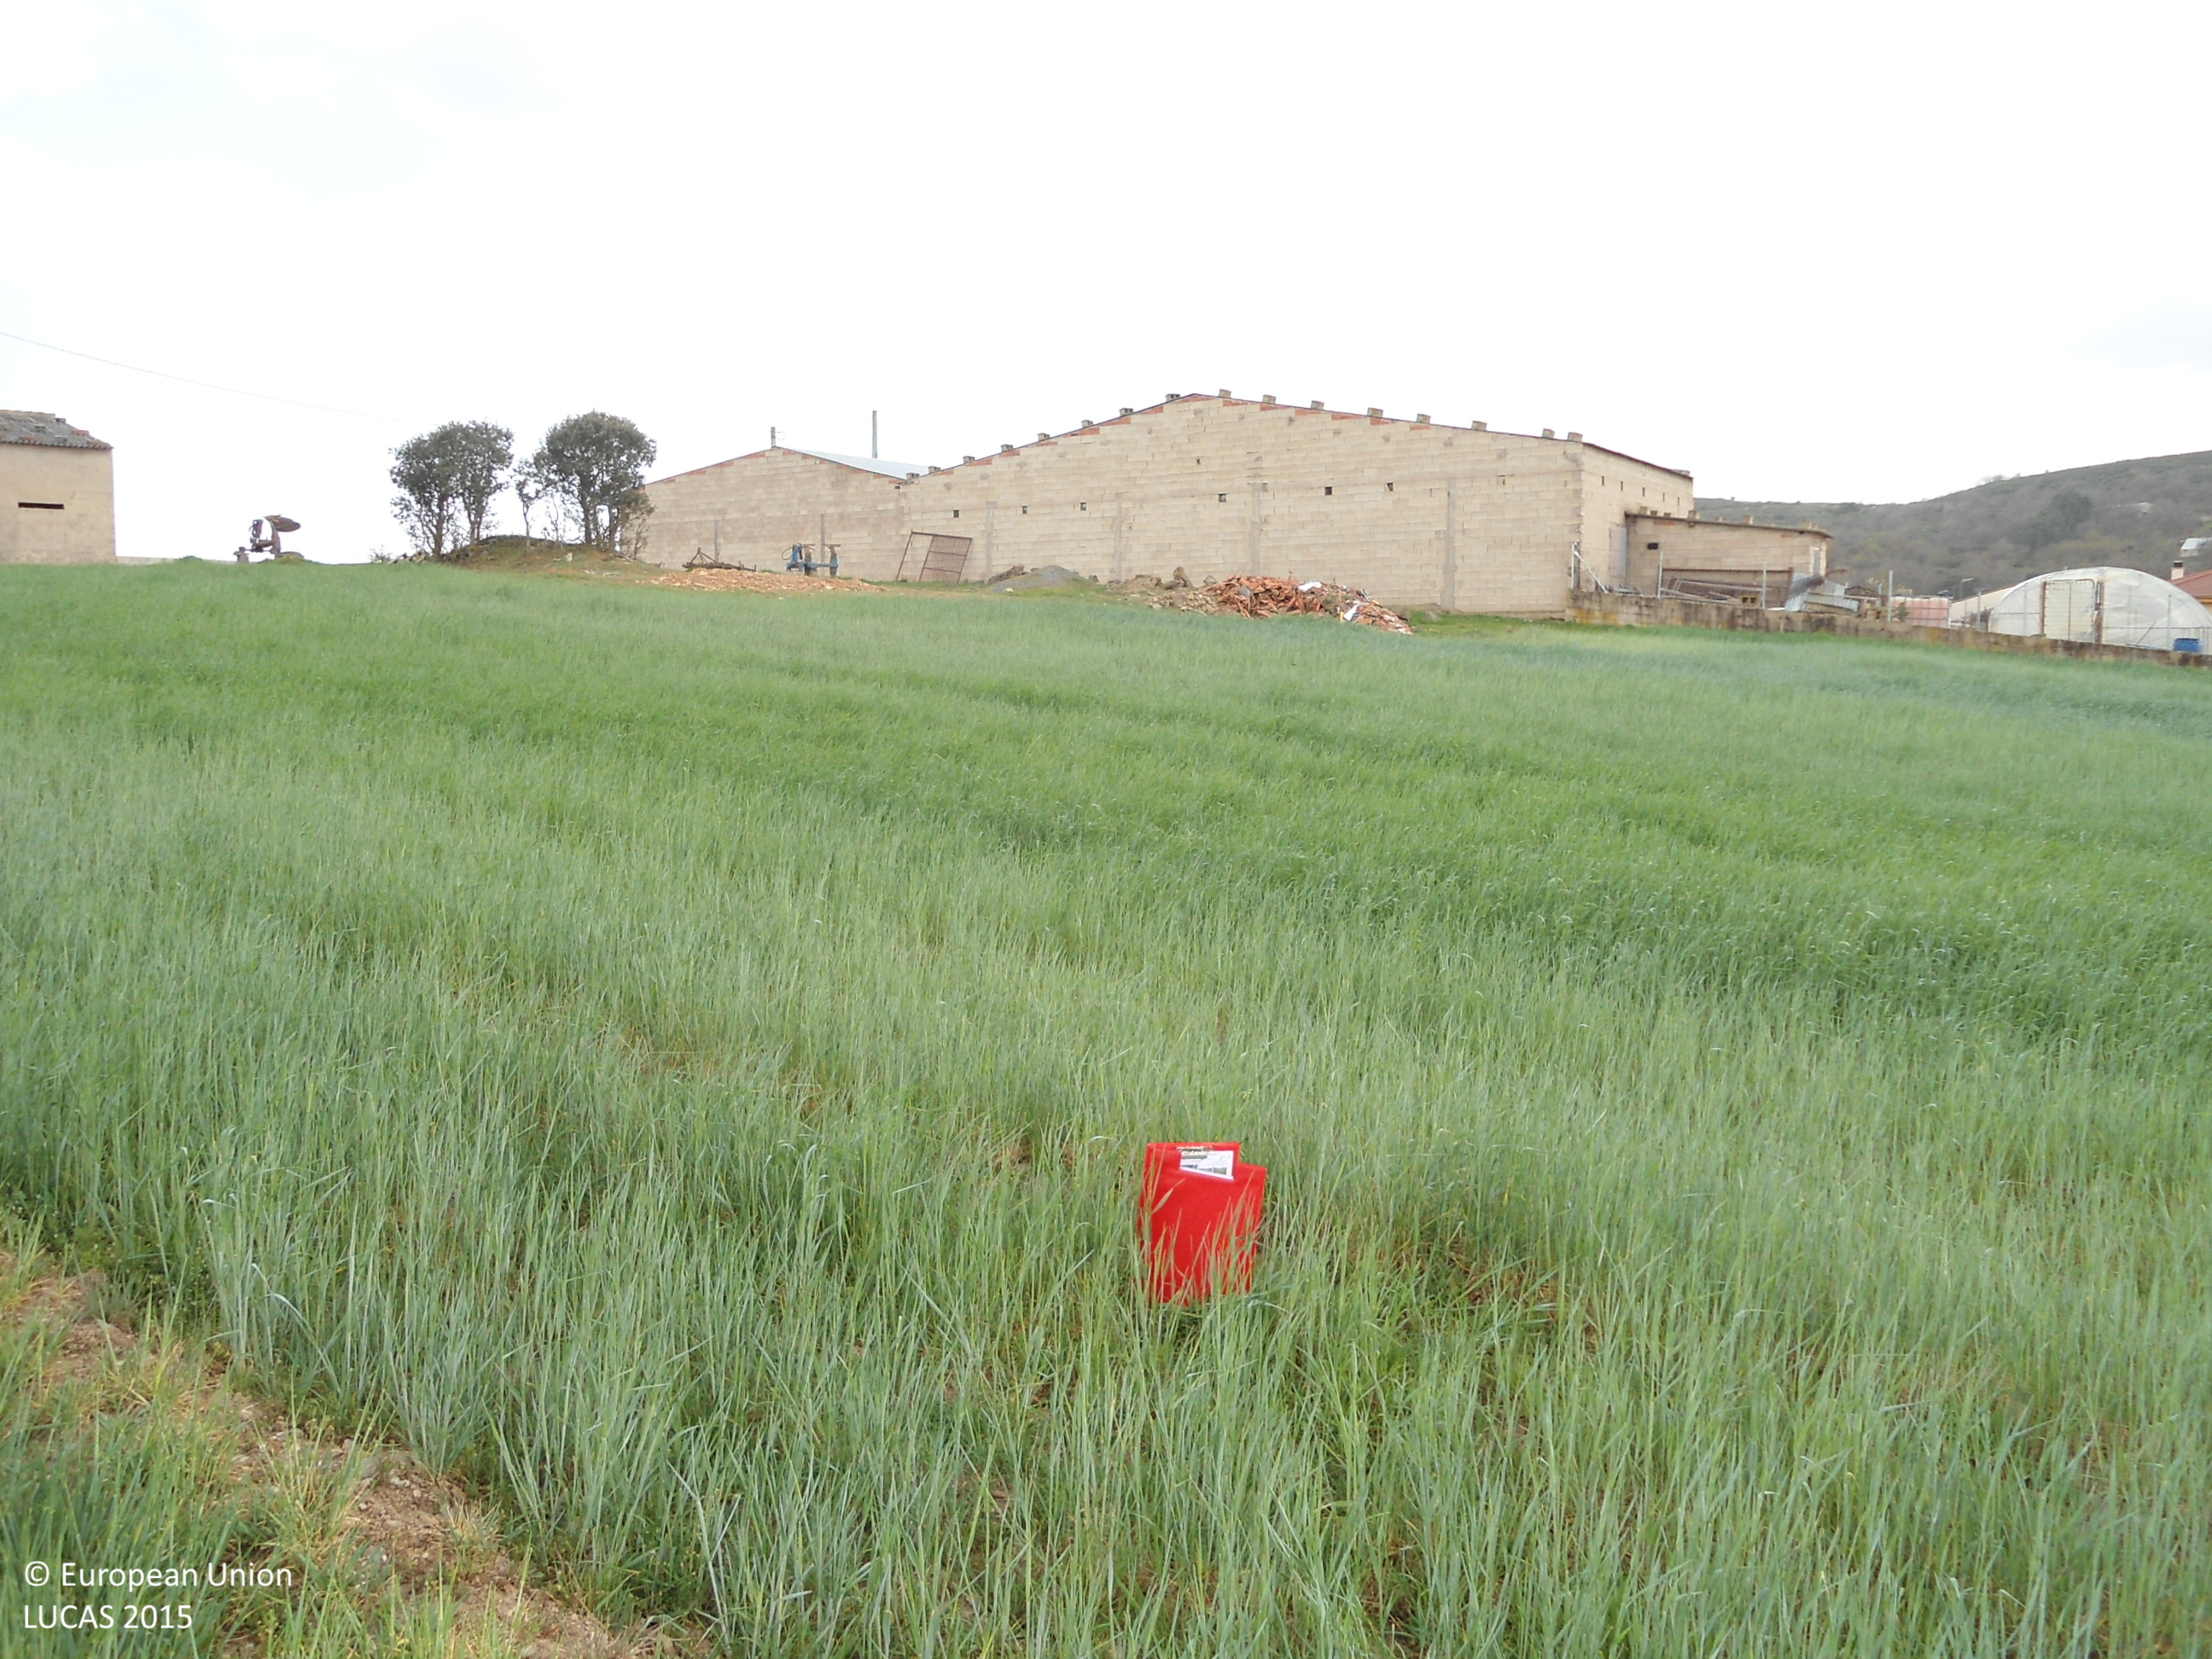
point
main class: Cropland
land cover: Rye
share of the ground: > 75 %
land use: Agriculture (excluding fallow land and kitchen gardens)
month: April
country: ES
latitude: 41.8244
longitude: -6.2715
